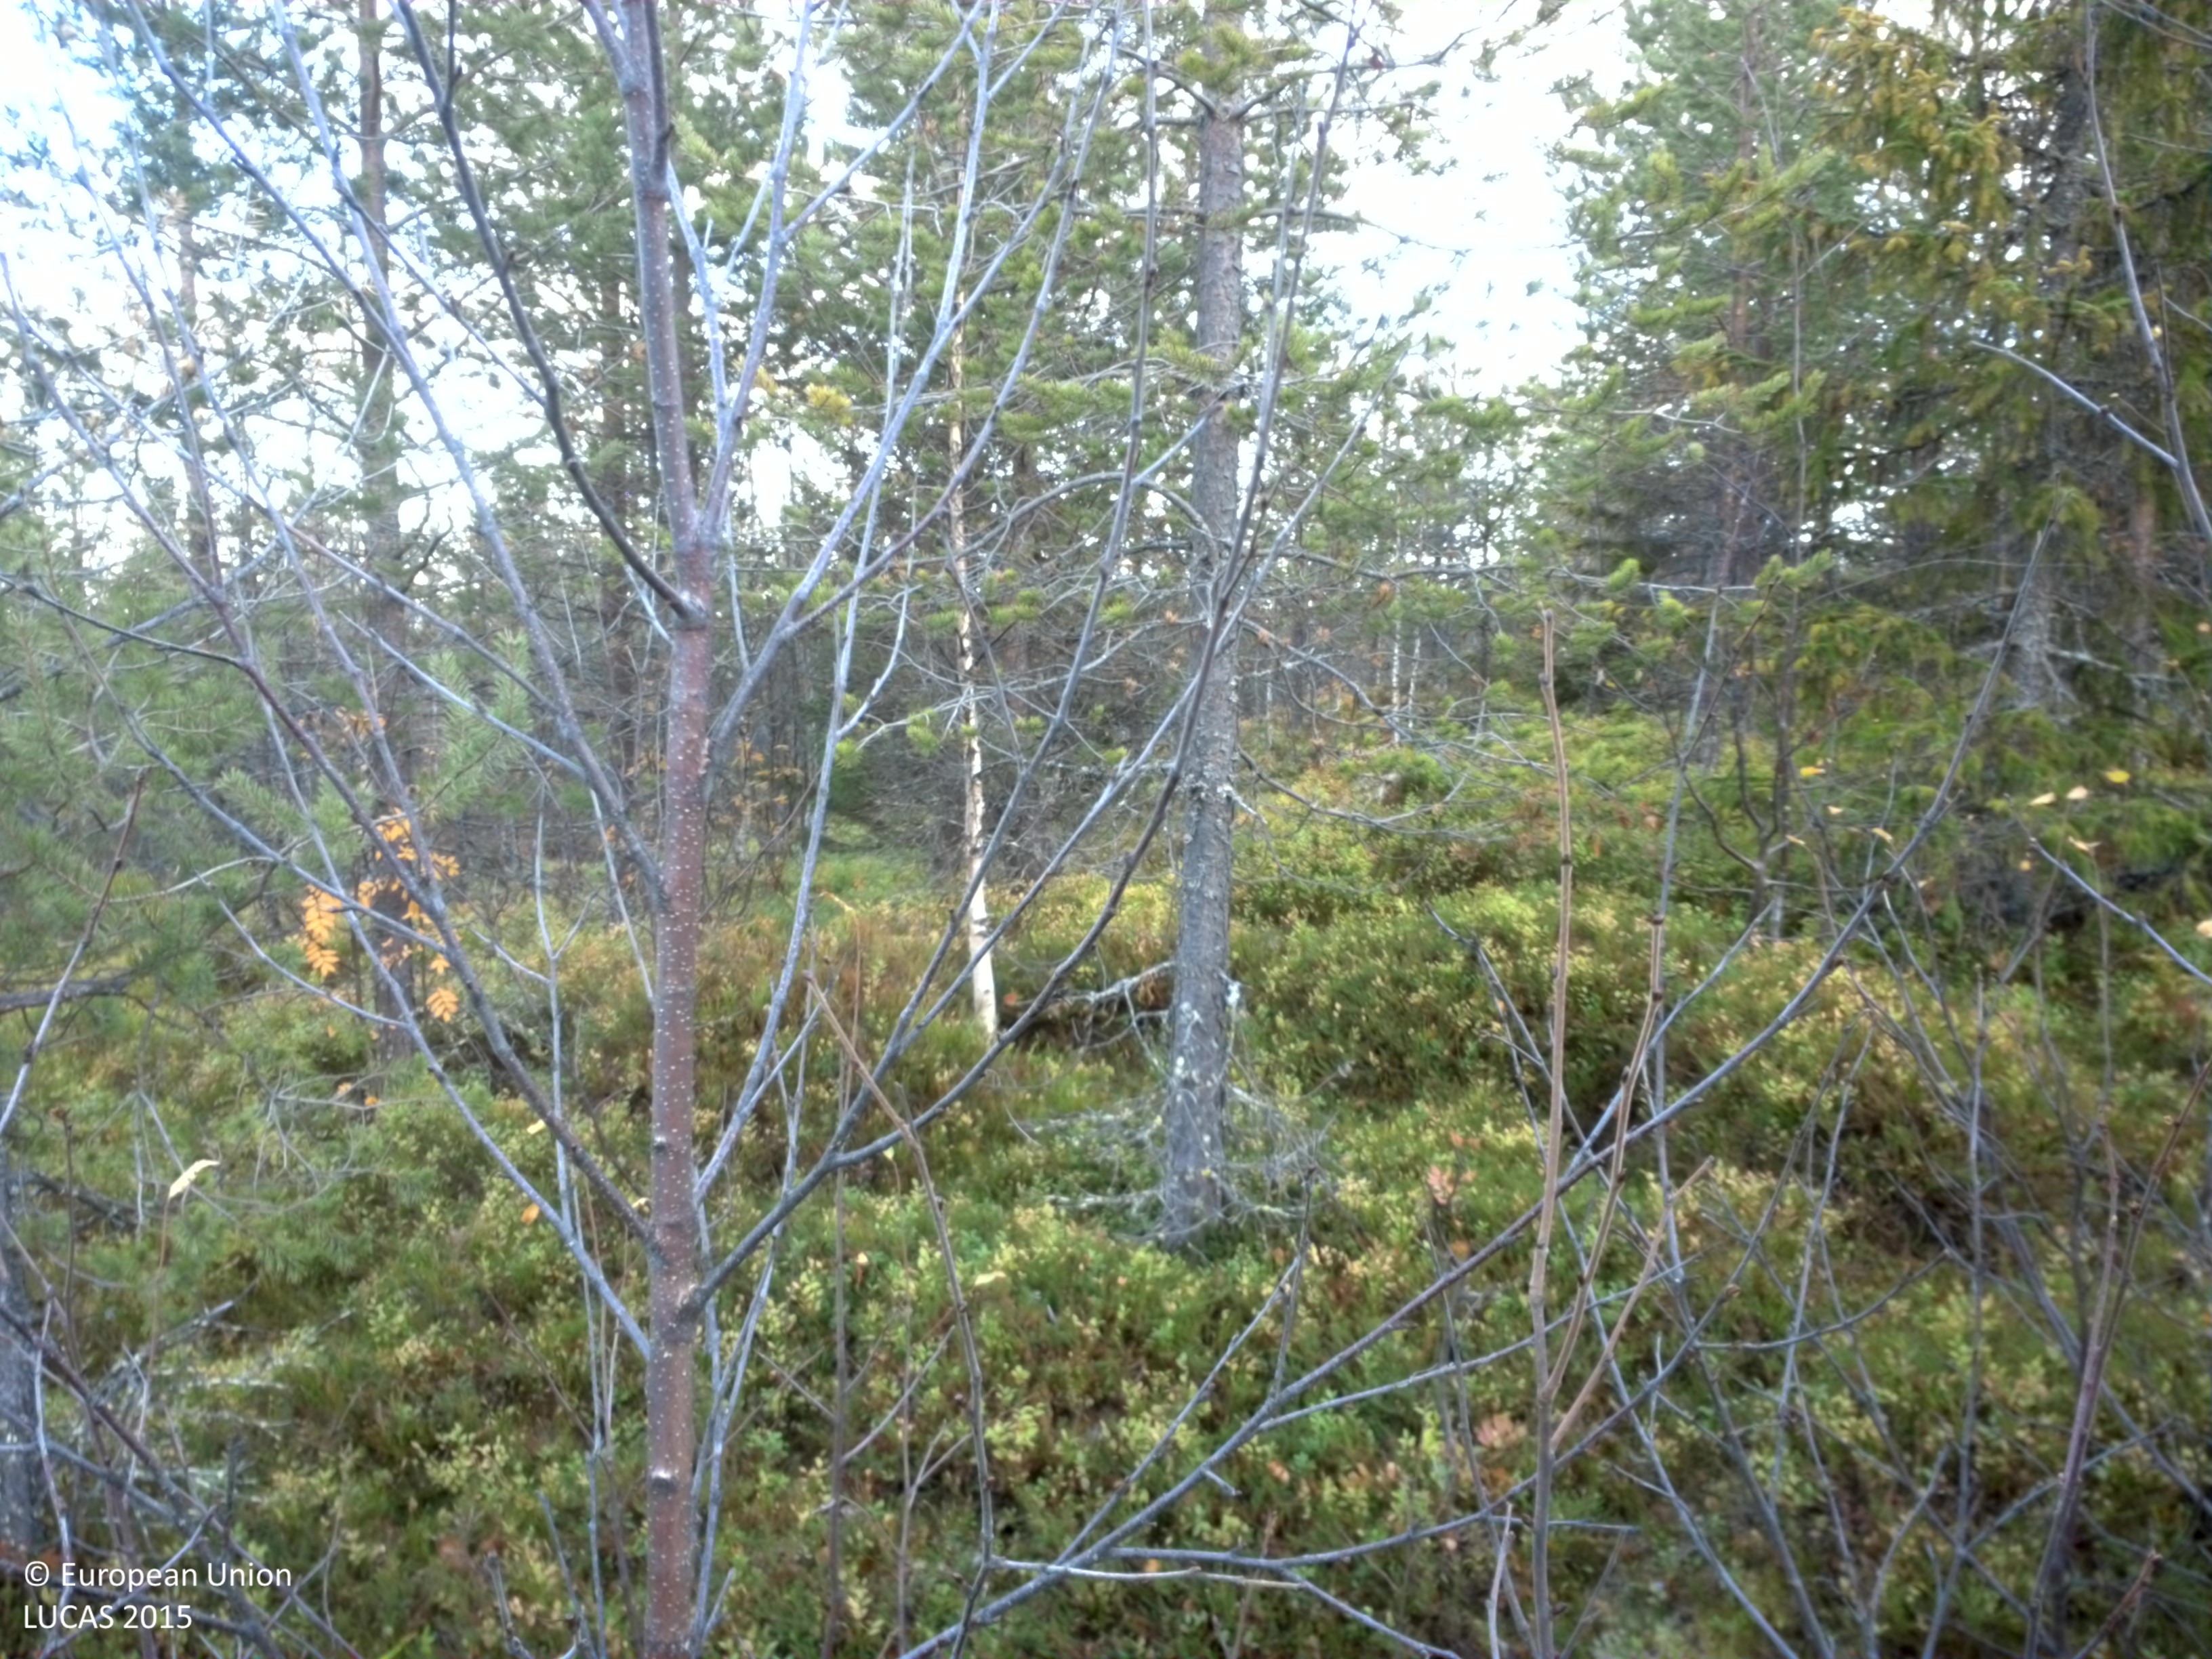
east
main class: Woodland
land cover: Pine dominated mixed woodland
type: boreal forest
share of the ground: 25 - 50 %
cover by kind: shrubs 40 %, coniferous forest trees 20 %, herbaceous plants 20 %, broadleaved forest trees 10 %, lichens and mosses 10 %
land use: Forestry
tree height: > 5 m
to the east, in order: Pine dominated mixed woodland; Ditches and canals; Pine dominated mixed woodland; Spruce dominated mixed woodland
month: October
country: SE
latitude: 64.7648
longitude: 17.5122
